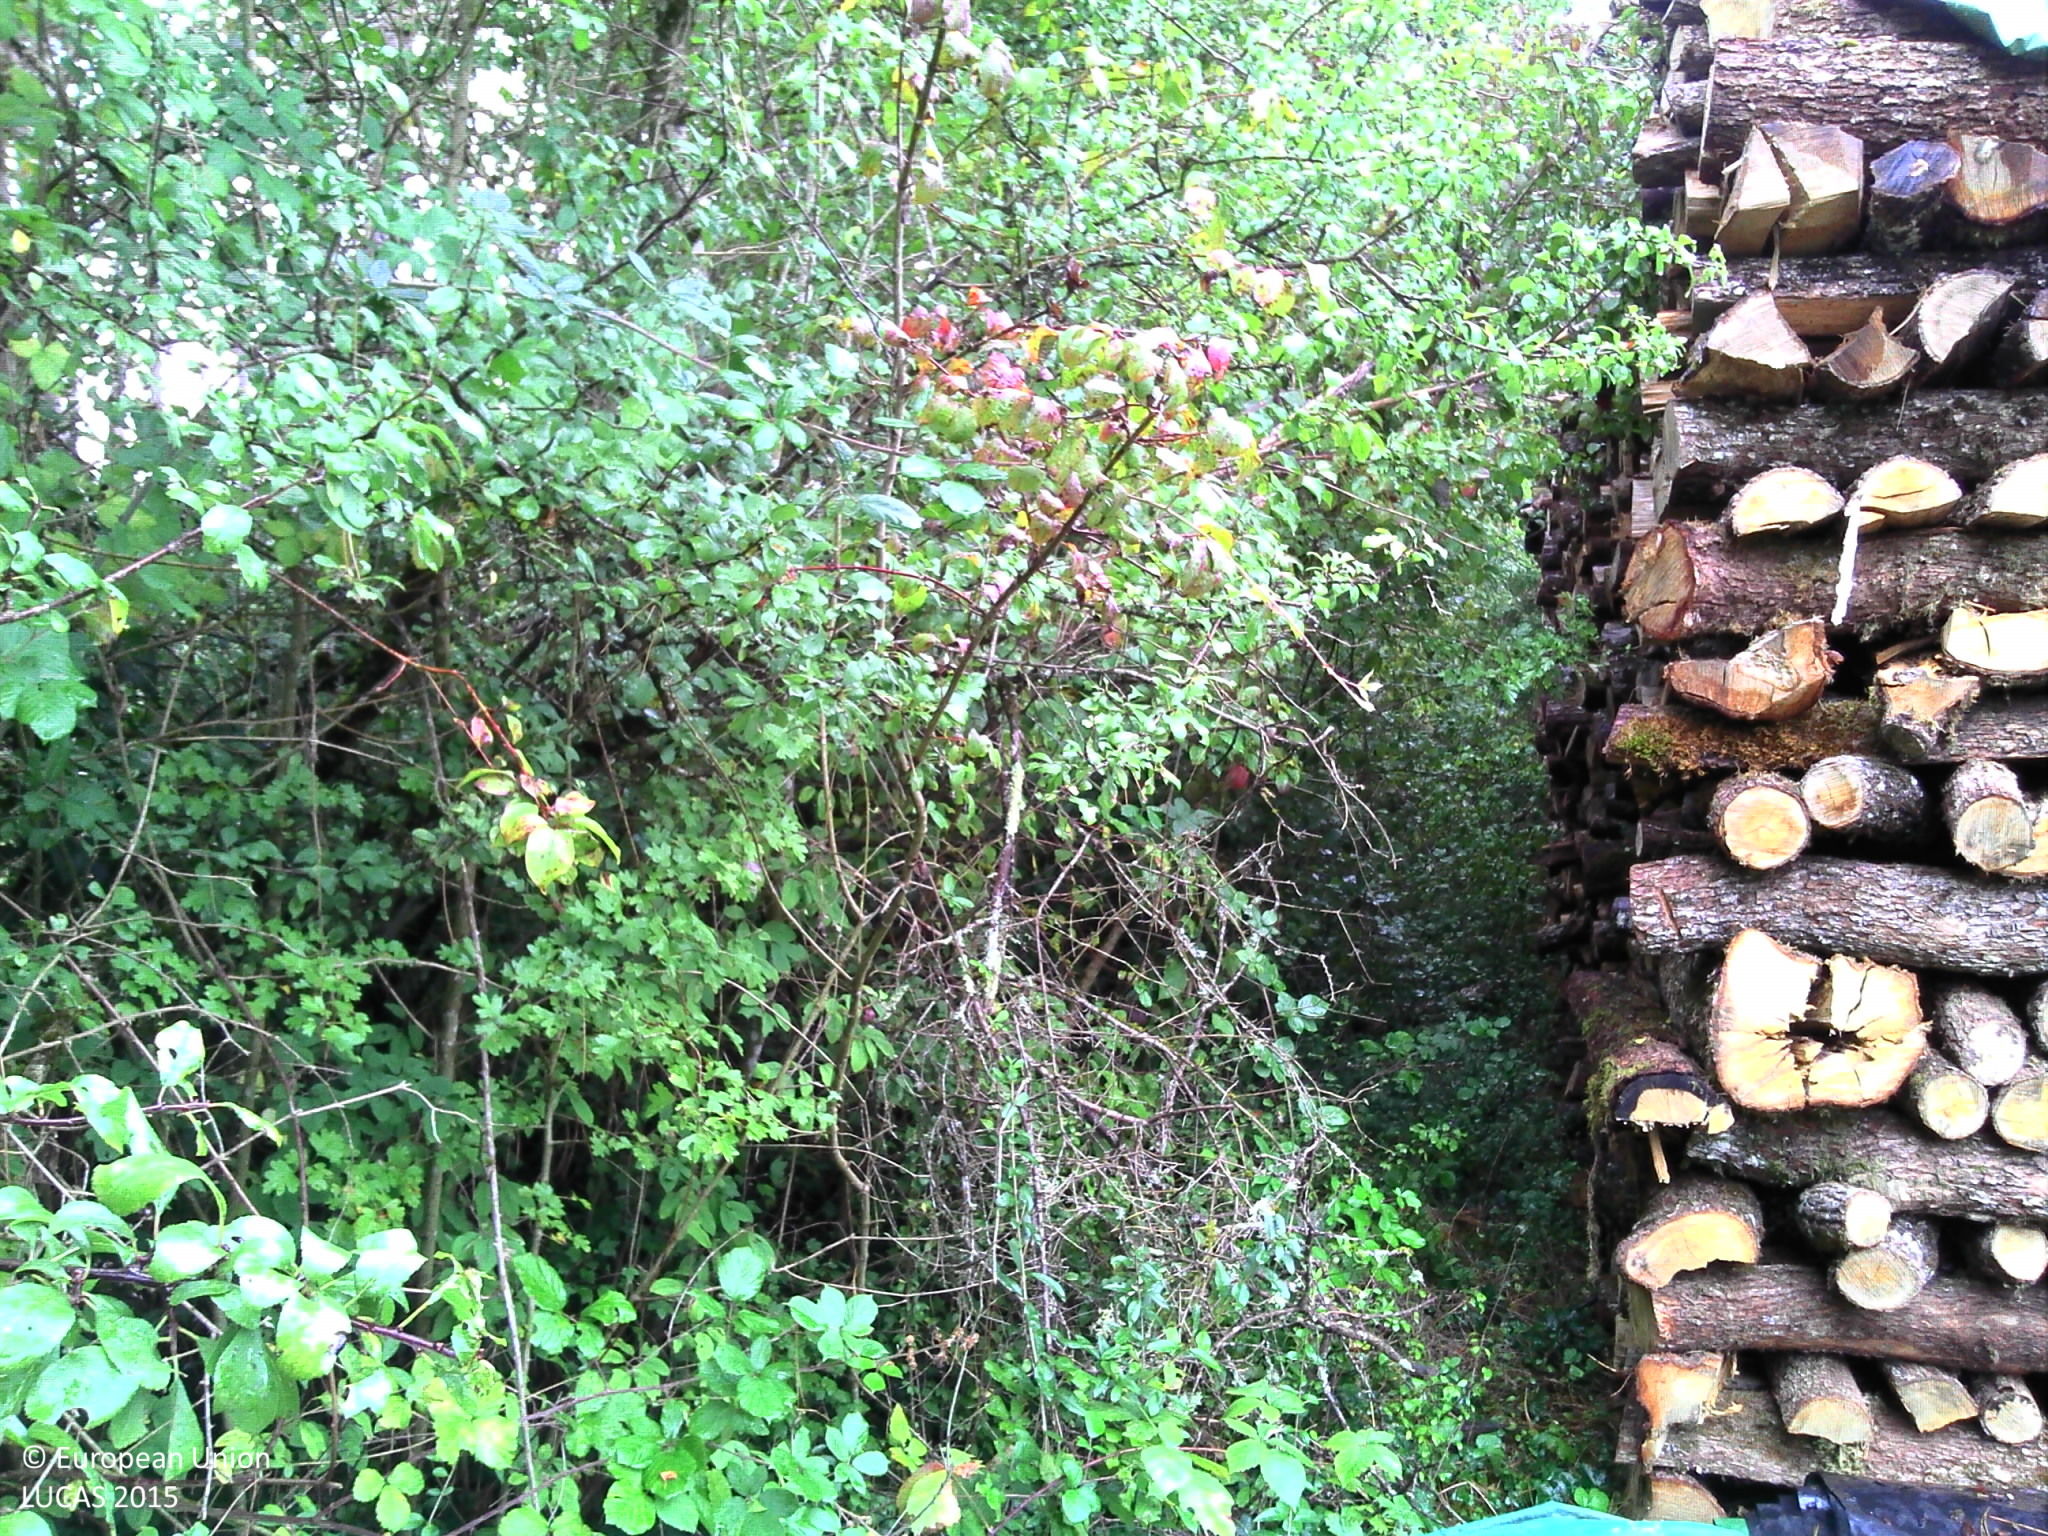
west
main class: Grassland
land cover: Grassland without tree/shrub cover
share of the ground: > 75 %
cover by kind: herbaceous plants 100 %
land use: Agriculture (excluding fallow land and kitchen gardens)
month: September
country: FR
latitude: 47.0728
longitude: 4.7988
